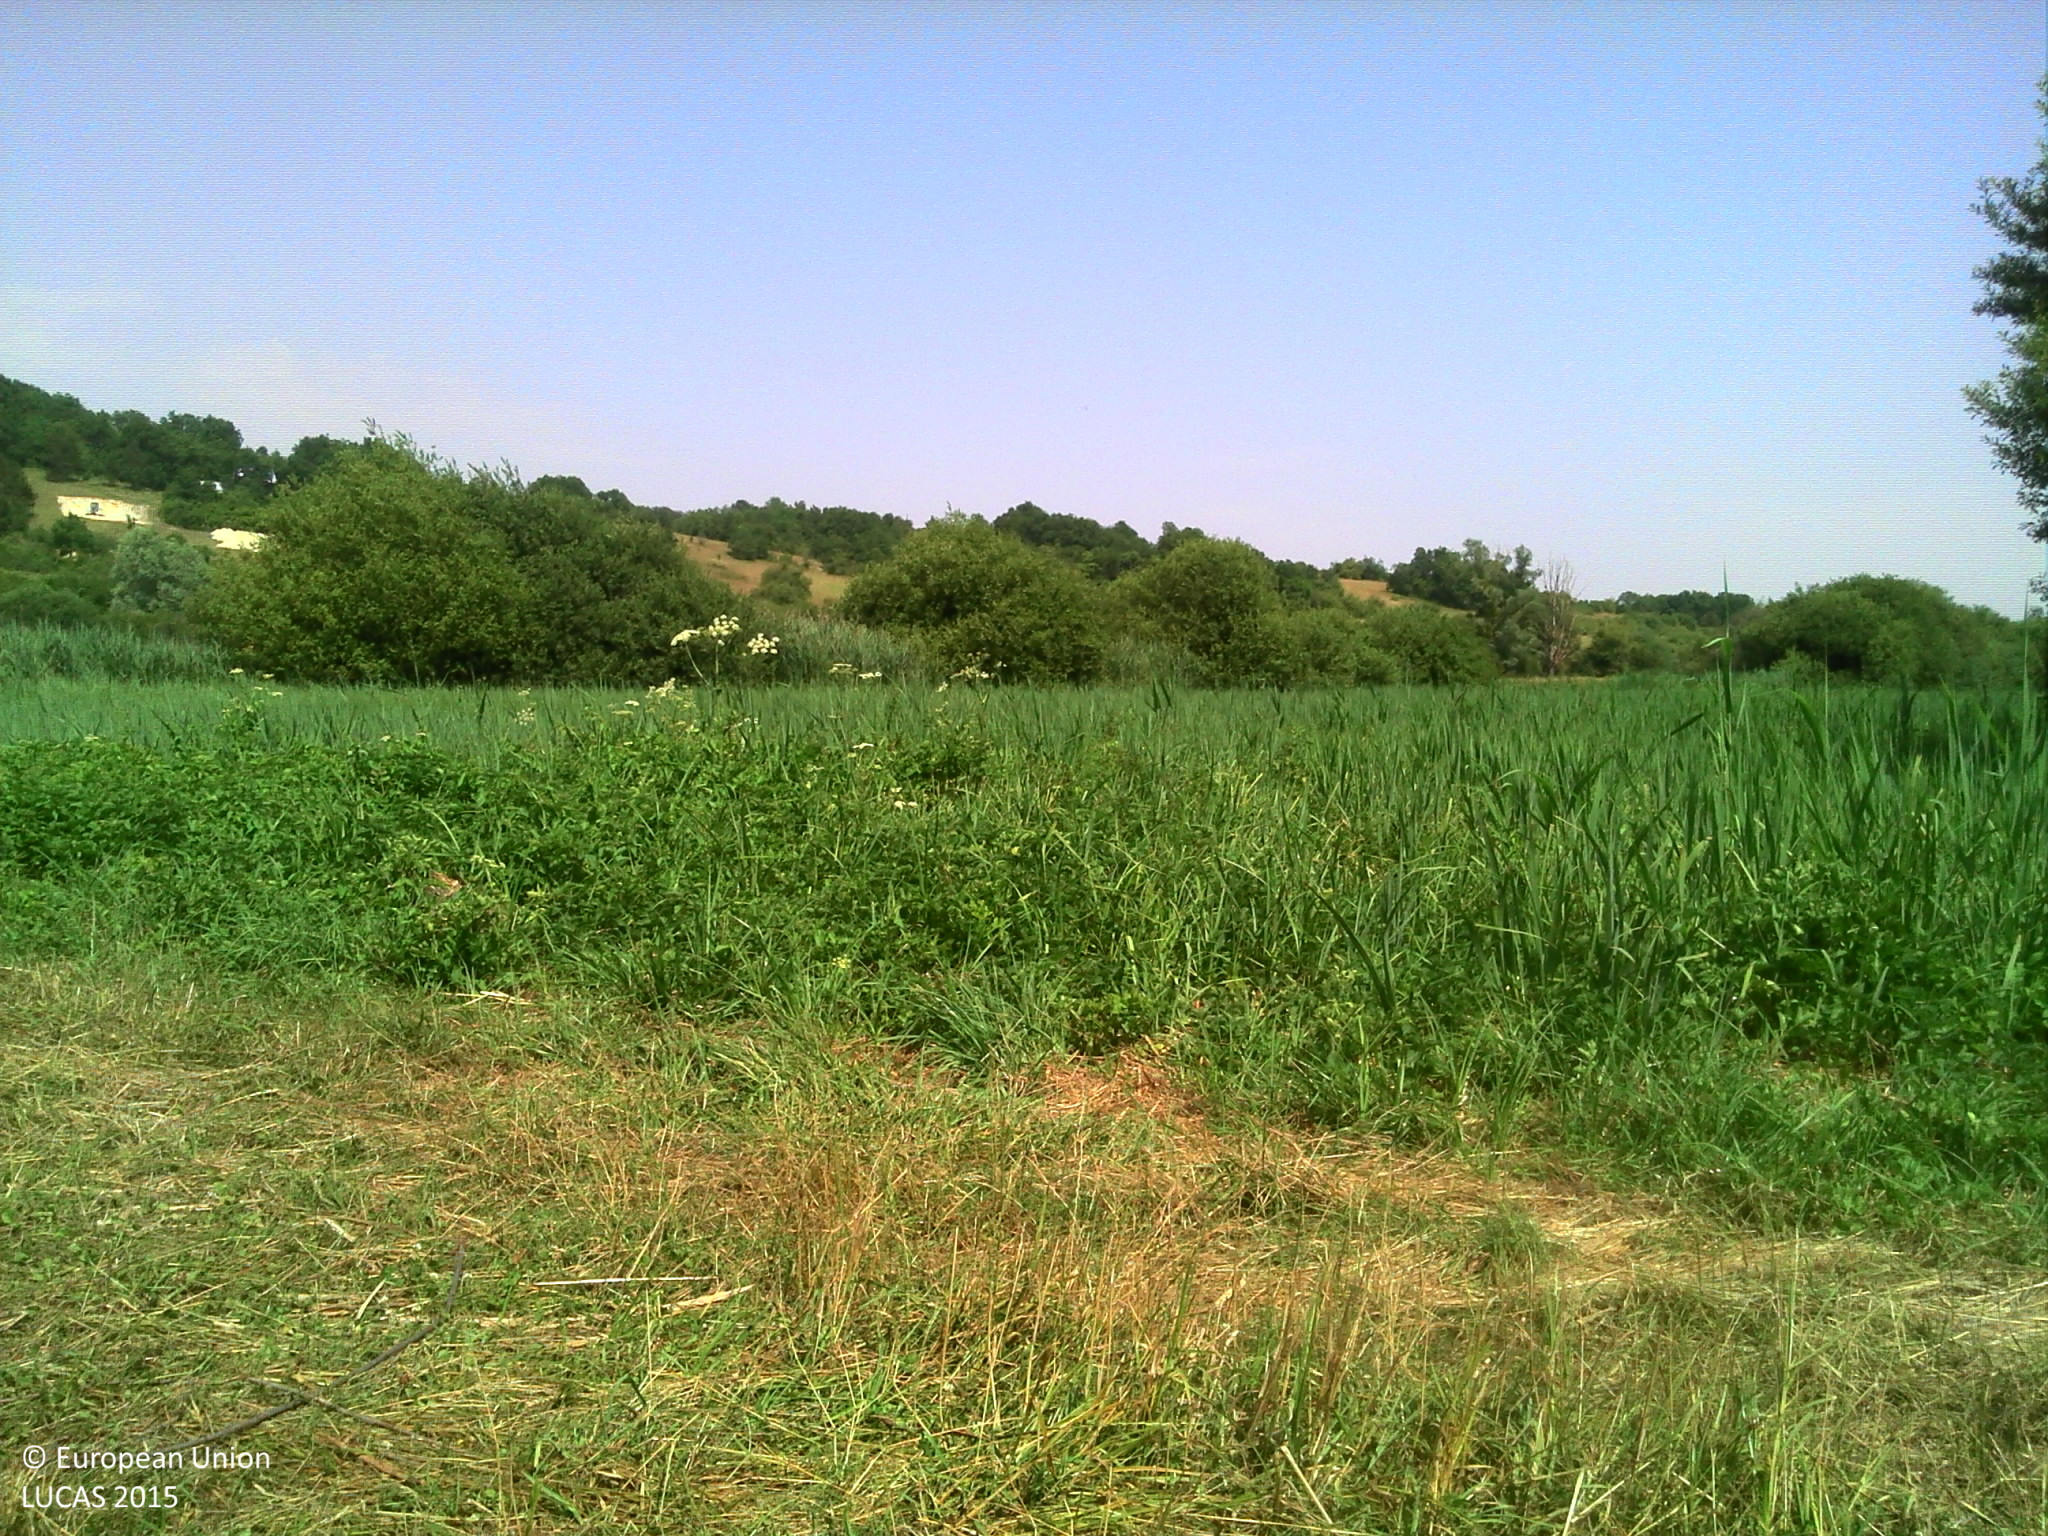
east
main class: Grassland
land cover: Grassland without tree/shrub cover
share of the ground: > 75 %
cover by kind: herbaceous plants 100 %
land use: Agriculture (excluding fallow land and kitchen gardens)
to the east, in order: Grassland without tree/shrub cover; Grass margins; Spontaneously vegetated surfaces; Broadleaved woodland; Grassland with sparse tree/shrub cover; Other fibre and oleaginous crops
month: July
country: FR
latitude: 47.5247
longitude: 3.4749
